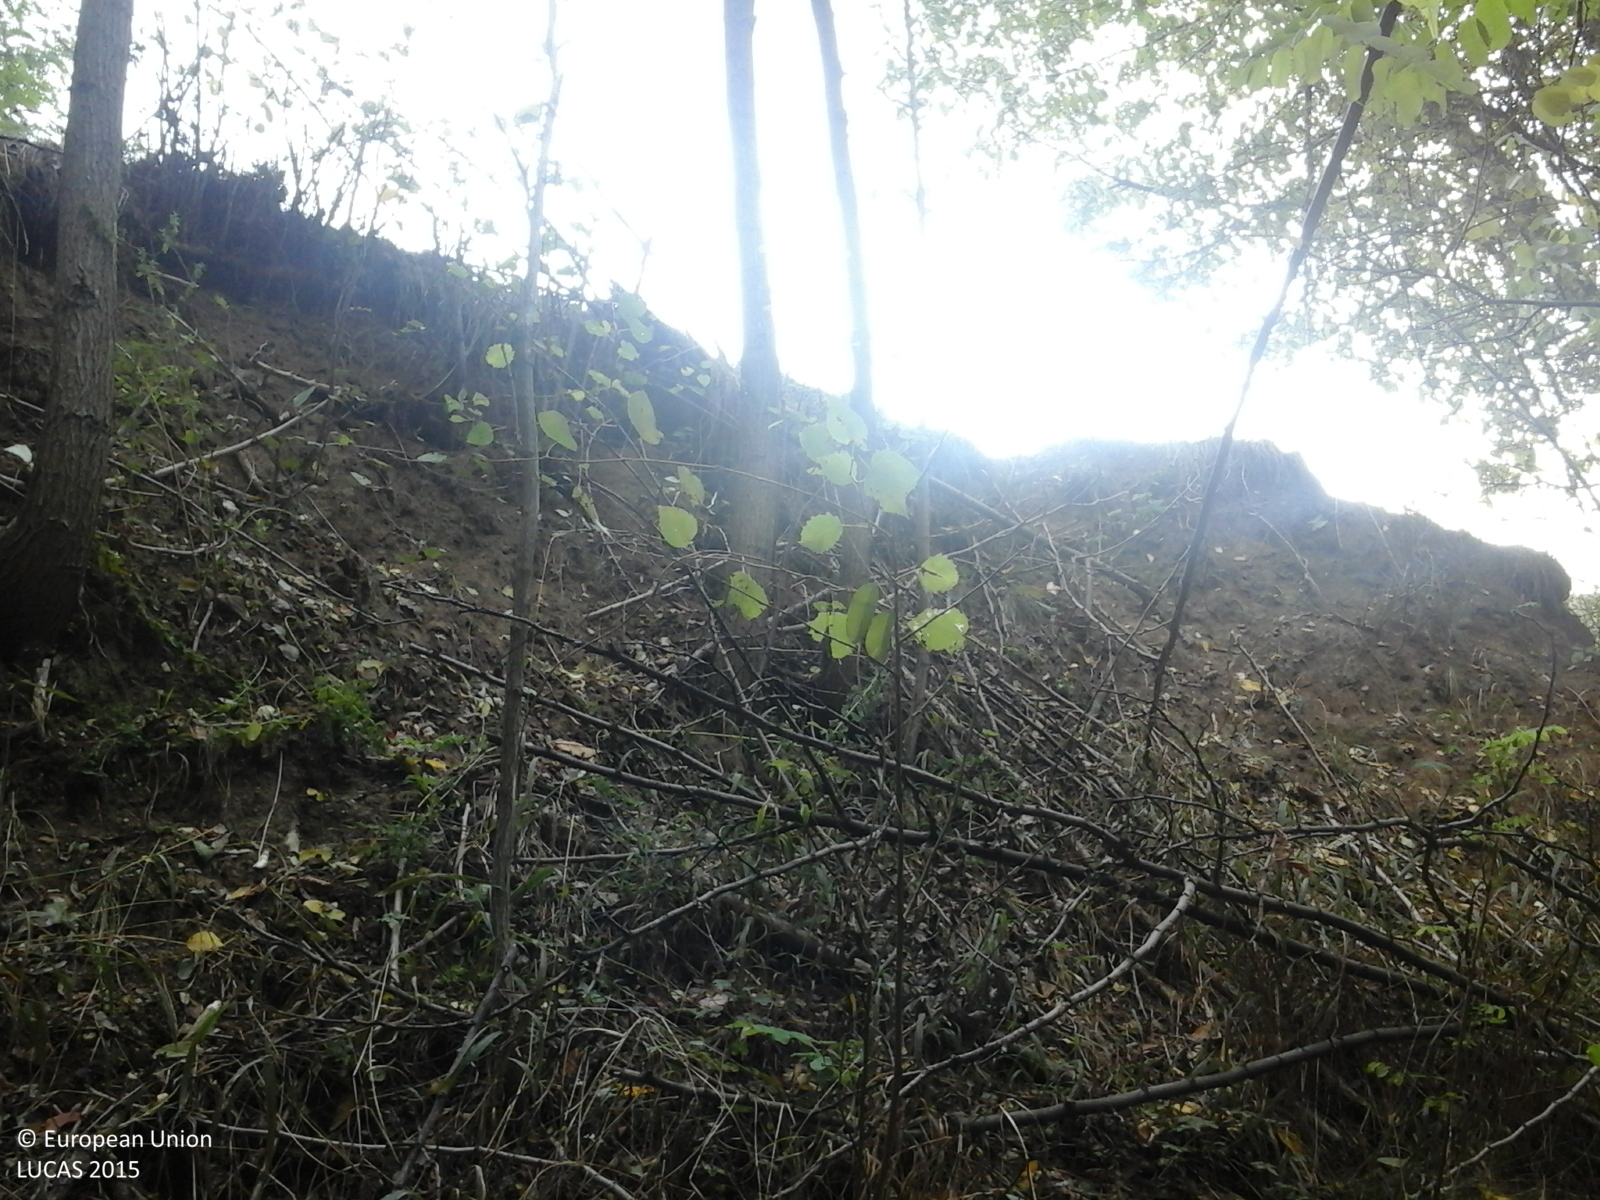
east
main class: Woodland
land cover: Broadleaved woodland
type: exotic forest
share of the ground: > 75 %
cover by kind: broadleaved forest trees 100 %
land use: Forestry
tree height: > 5 m
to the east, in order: Broadleaved woodland; Grassland without tree/shrub cover; Single bushes/trees; Spontaneously vegetated surfaces; Single bushes/trees; Grassland without tree/shrub cover
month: October
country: RO
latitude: 46.3917
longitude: 25.3323
